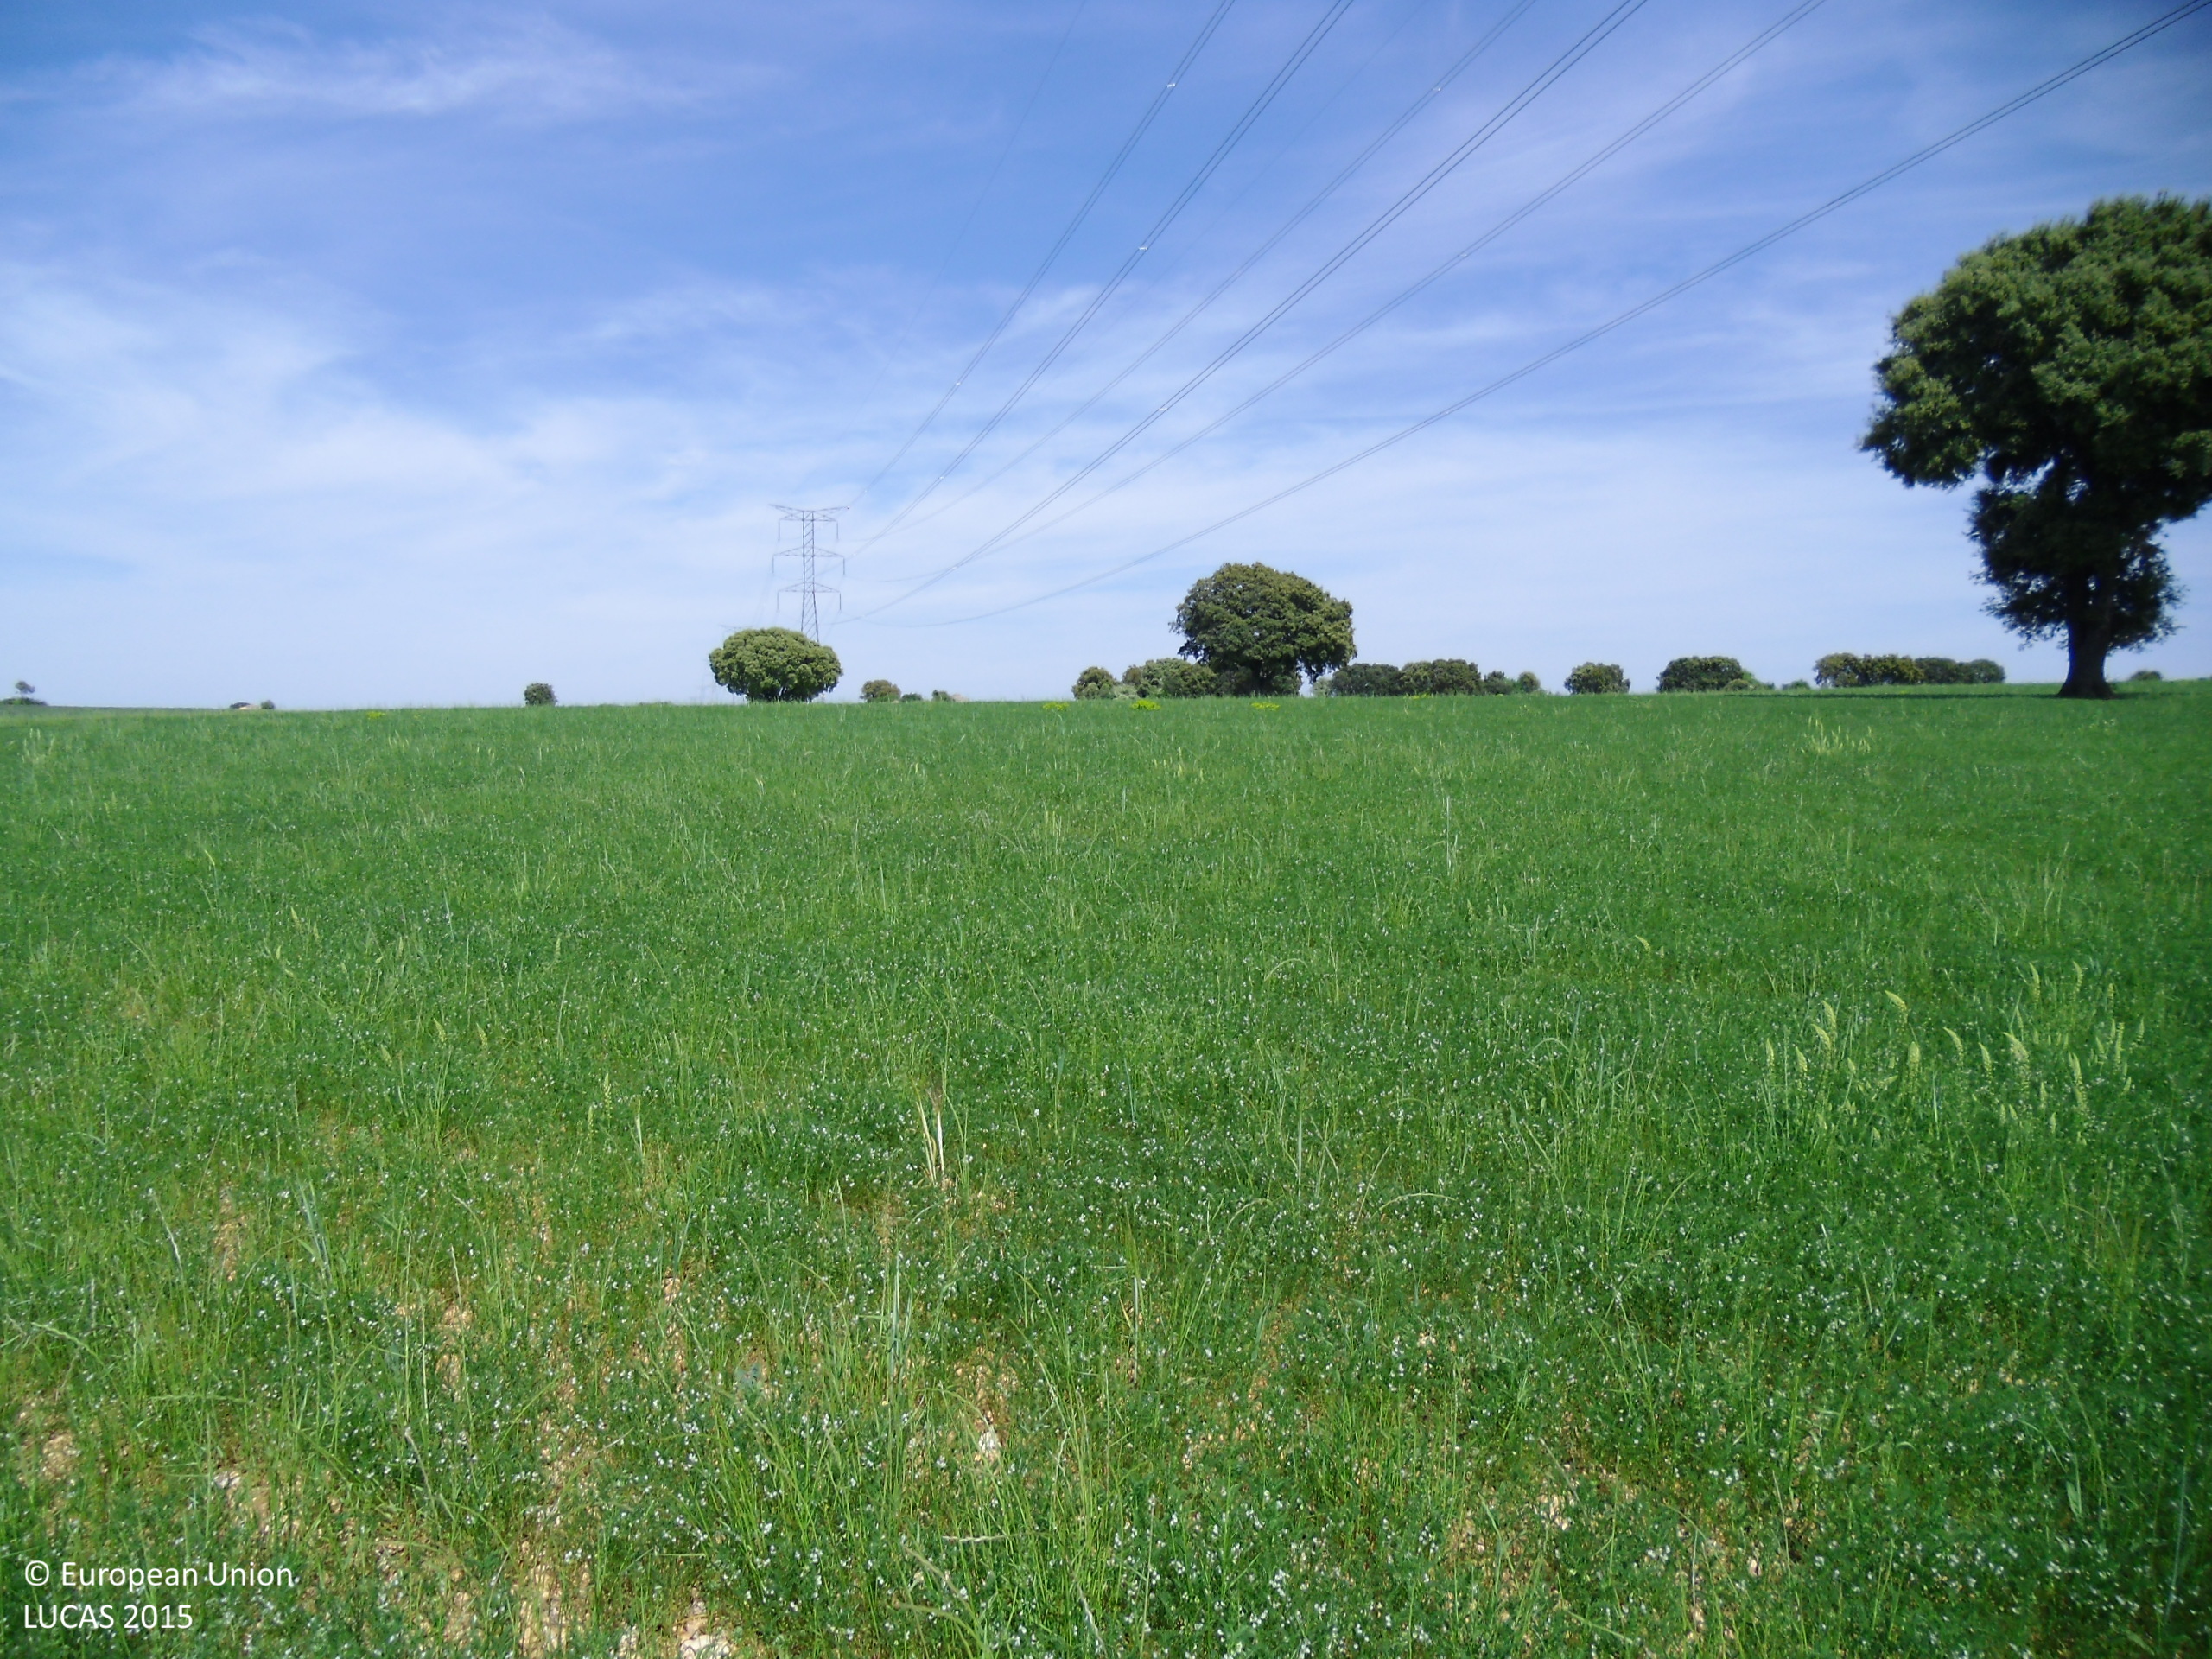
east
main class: Cropland
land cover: Dry pulses
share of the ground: > 75 %
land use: Agriculture (excluding fallow land and kitchen gardens)
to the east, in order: Dry pulses; Single bushes/trees; Electric lines; Dry pulses; Grass margins; Tracks; Abandoned hedges; Barley
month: May
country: ES
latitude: 40.6071
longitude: -2.8526
